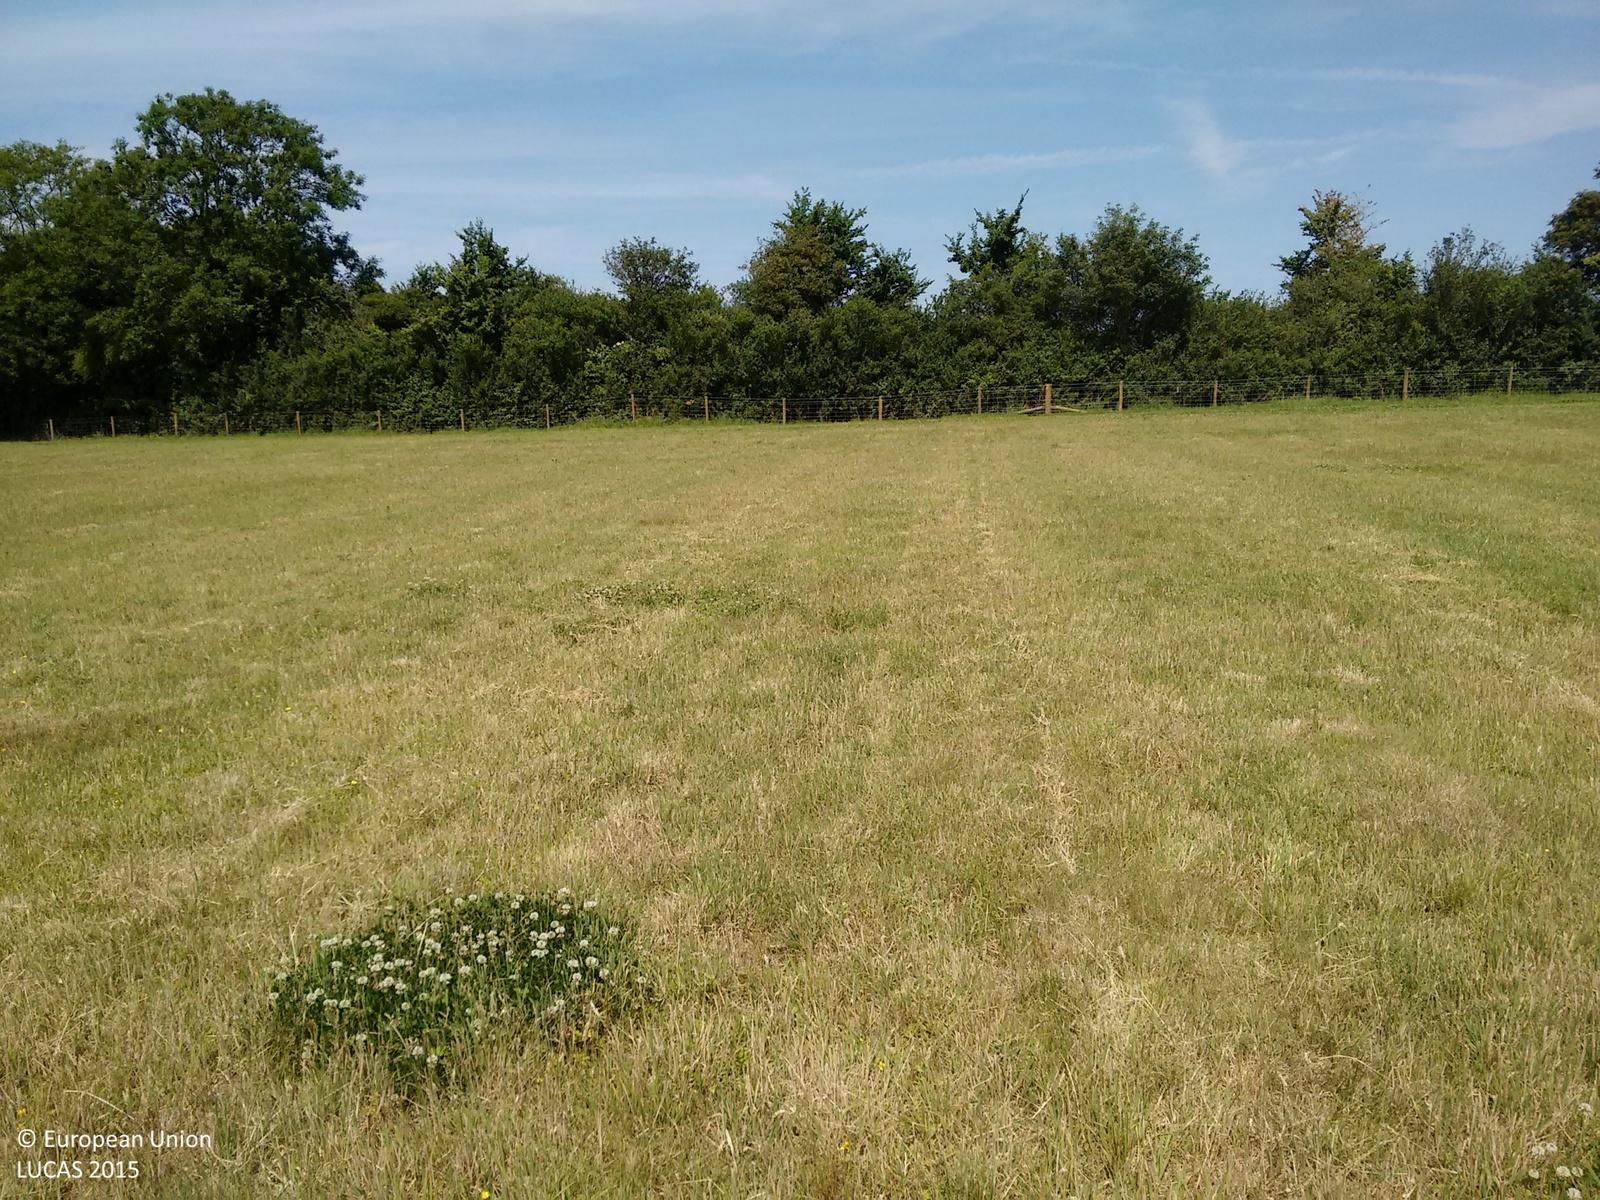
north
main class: Grassland
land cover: Grassland without tree/shrub cover
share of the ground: > 75 %
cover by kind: herbaceous plants 100 %
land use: Agriculture (excluding fallow land and kitchen gardens)
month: July
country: GB
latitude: 50.9240
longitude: -0.3795
